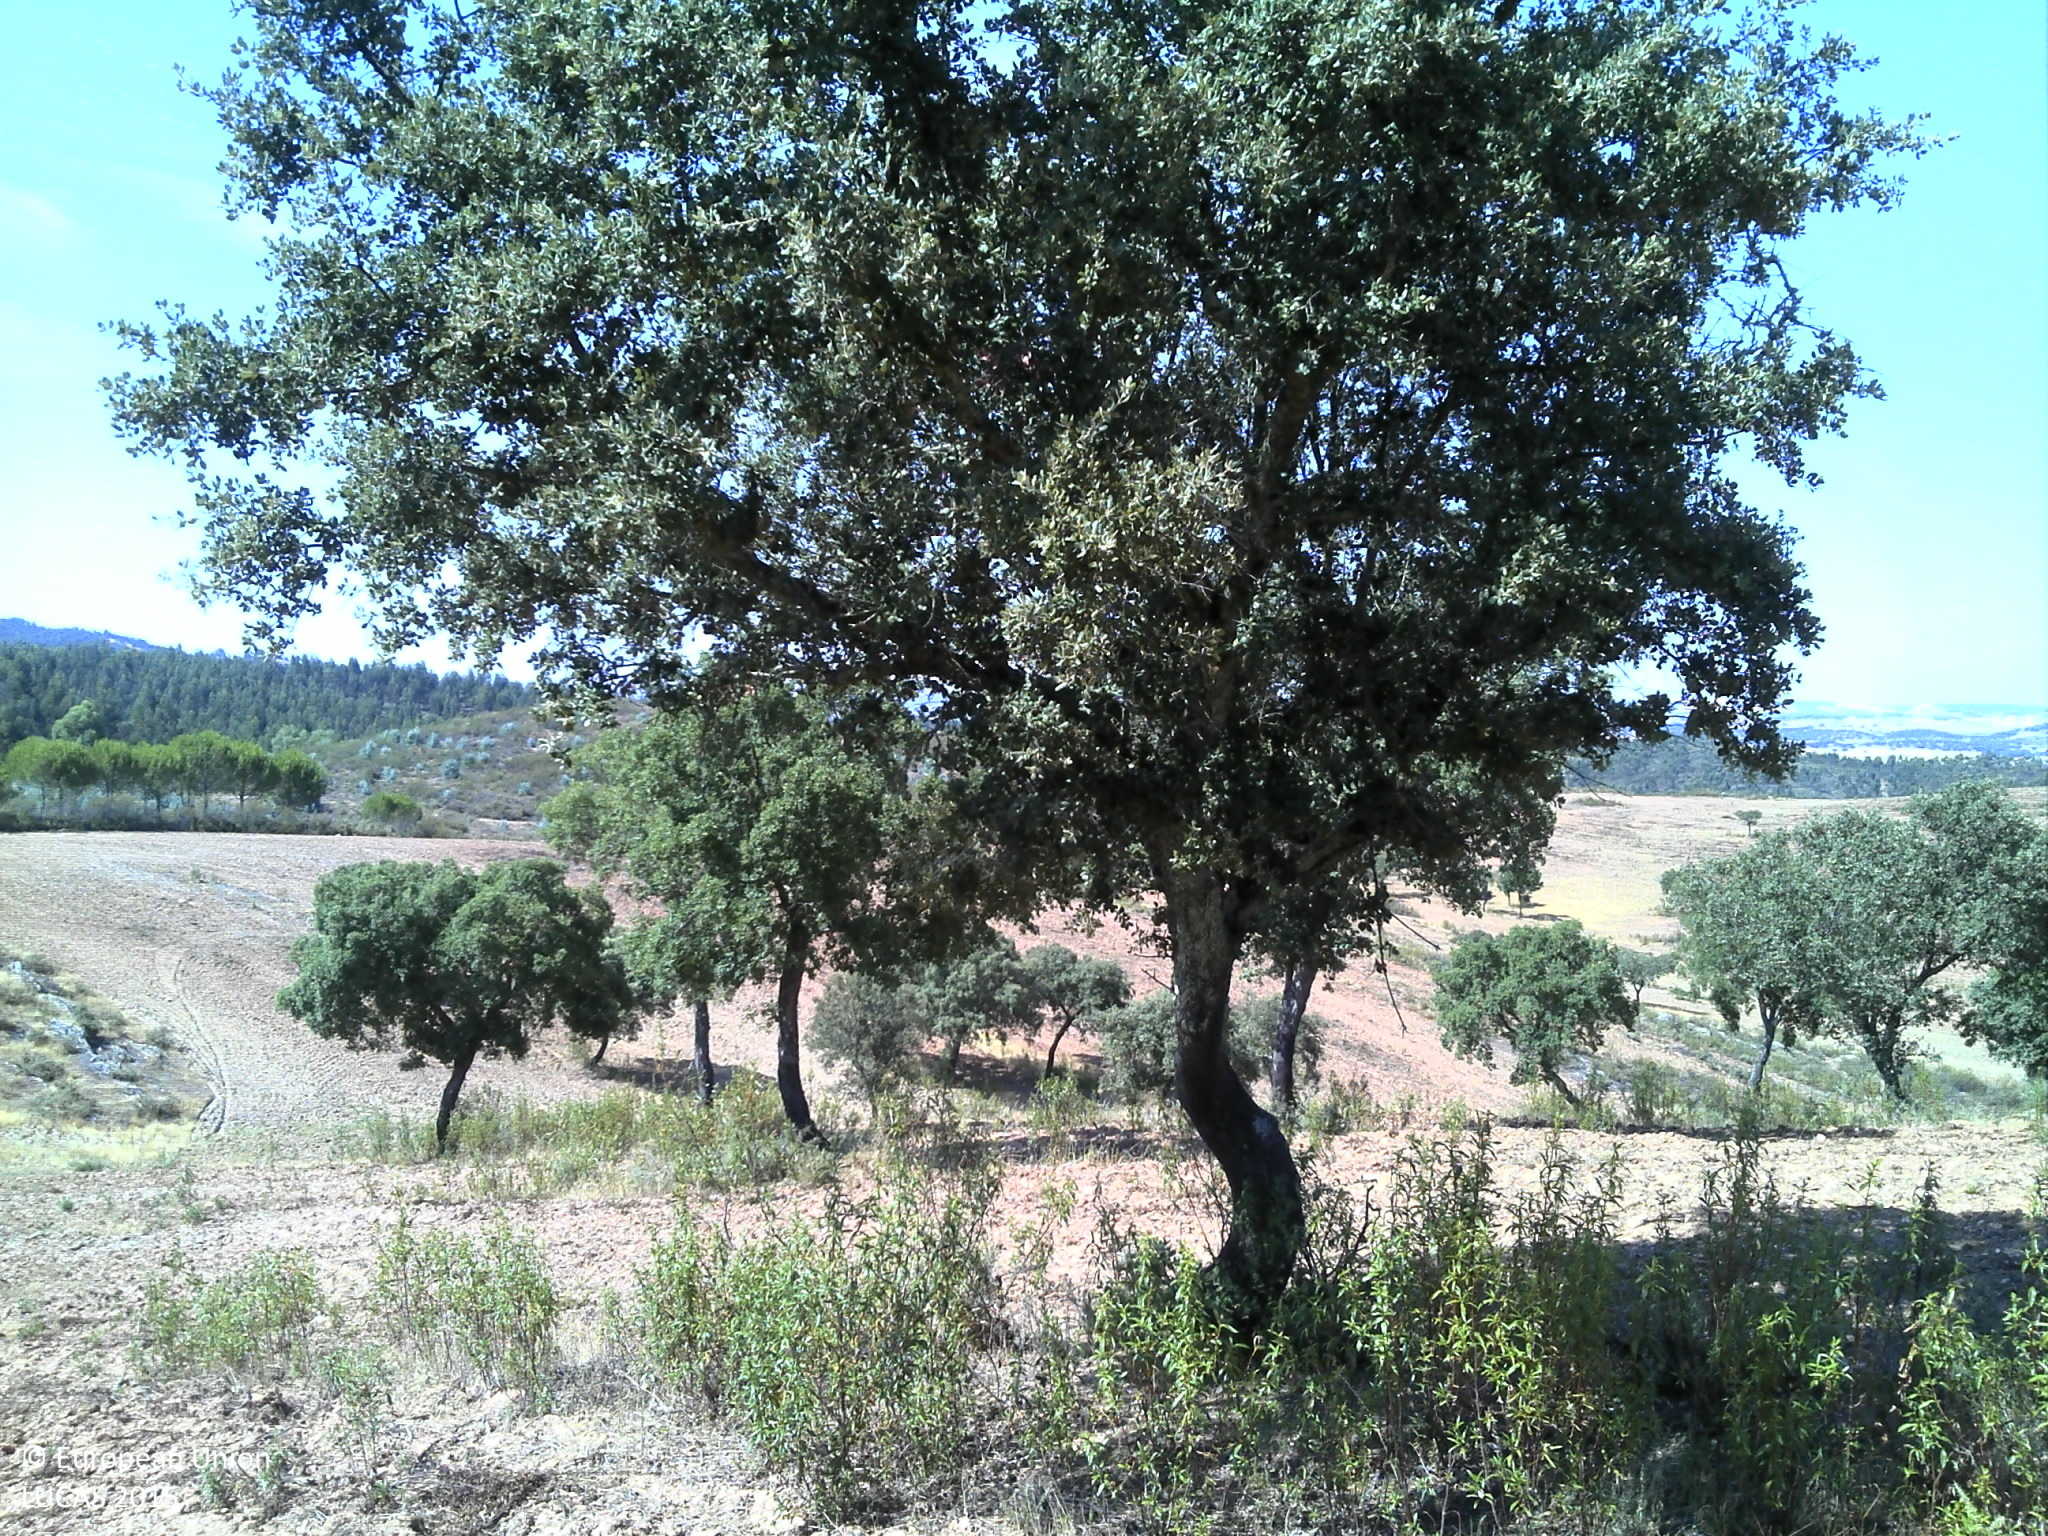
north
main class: Woodland
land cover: Broadleaved woodland
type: broadleaved evergreen forest
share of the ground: 10 - 25 %
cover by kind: unconsolidated bare surface 85 %, broadleaved forest trees 15 %
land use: Forestry
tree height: > 5 m
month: July
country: PT
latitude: 38.6994
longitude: -7.4980
